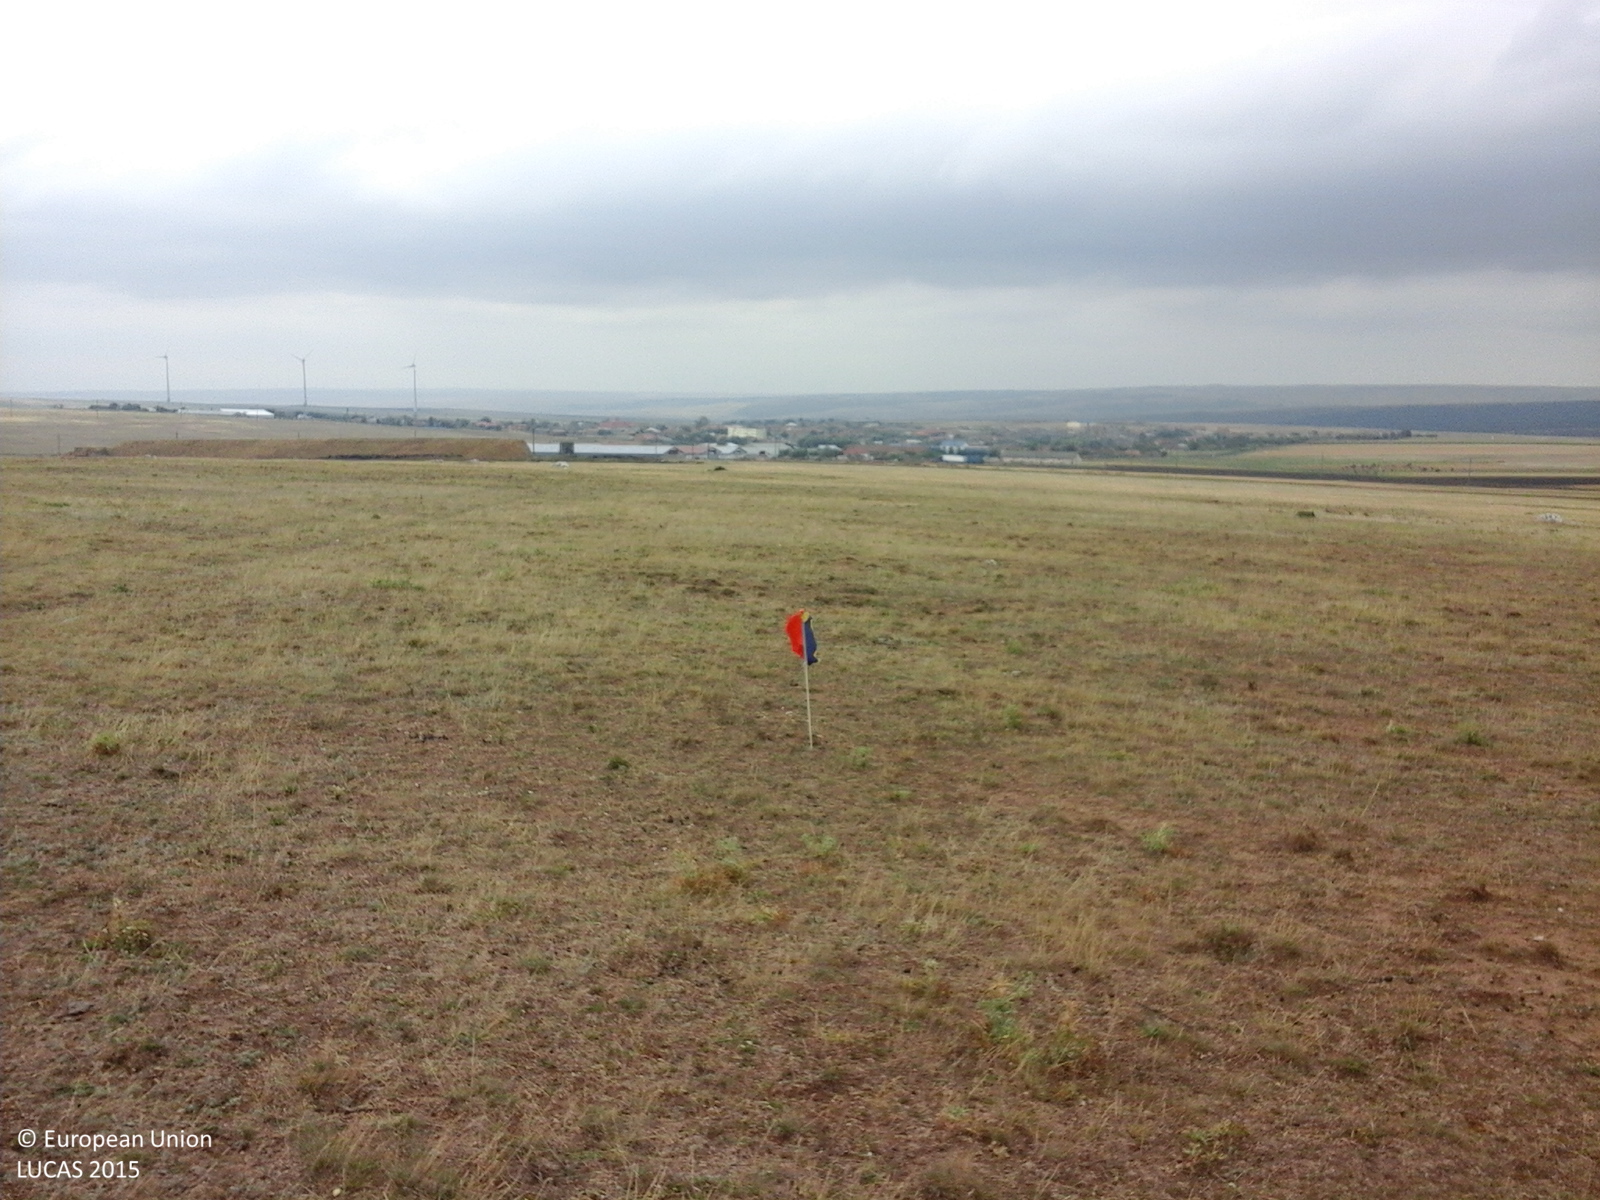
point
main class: Grassland
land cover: Grassland without tree/shrub cover
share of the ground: > 75 %
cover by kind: herbaceous plants 100 %
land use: Agriculture (excluding fallow land and kitchen gardens)
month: August
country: RO
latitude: 44.7851
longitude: 28.5426
